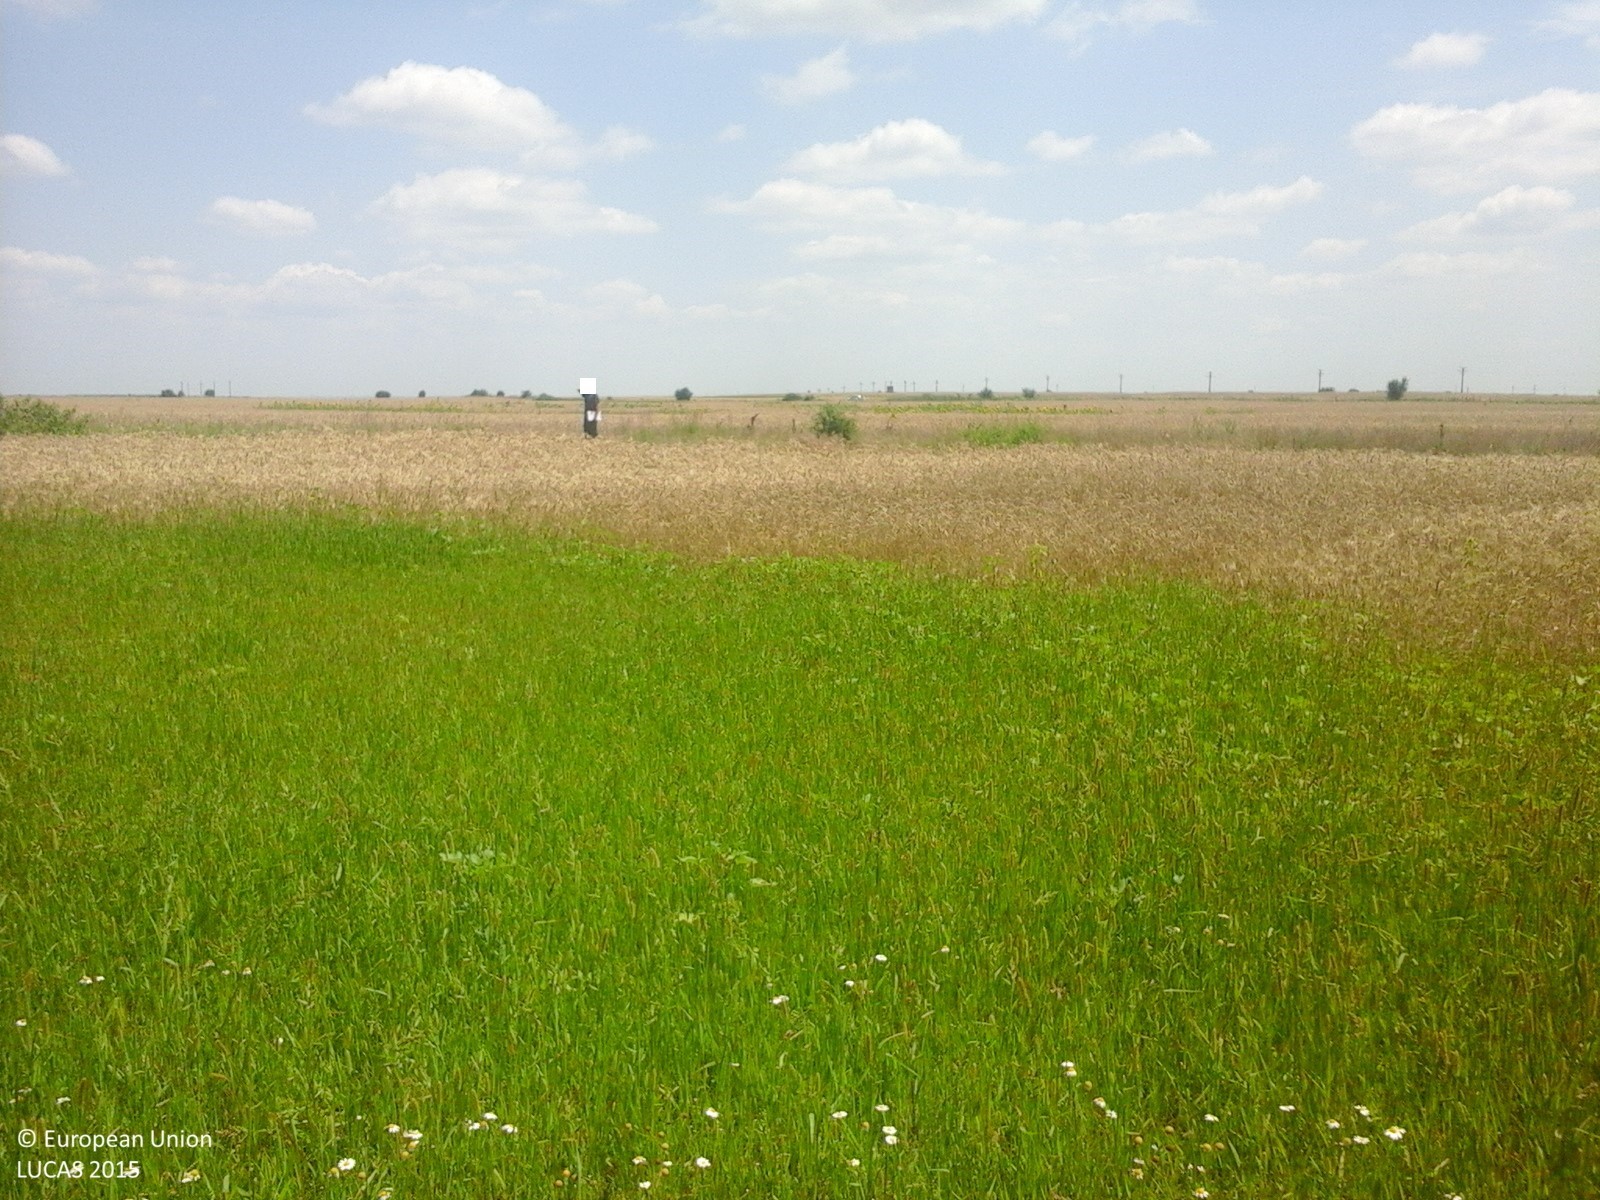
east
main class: Grassland
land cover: Grassland without tree/shrub cover
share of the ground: > 75 %
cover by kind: herbaceous plants 100 %
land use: Agriculture (excluding fallow land and kitchen gardens)
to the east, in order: Grassland without tree/shrub cover; Common wheat; Ditches and canals; Grassland without tree/shrub cover; Common wheat; Spontaneously vegetated surfaces; Common wheat; Spontaneously vegetated surfaces
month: July
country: RO
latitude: 44.1405
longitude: 24.3021
